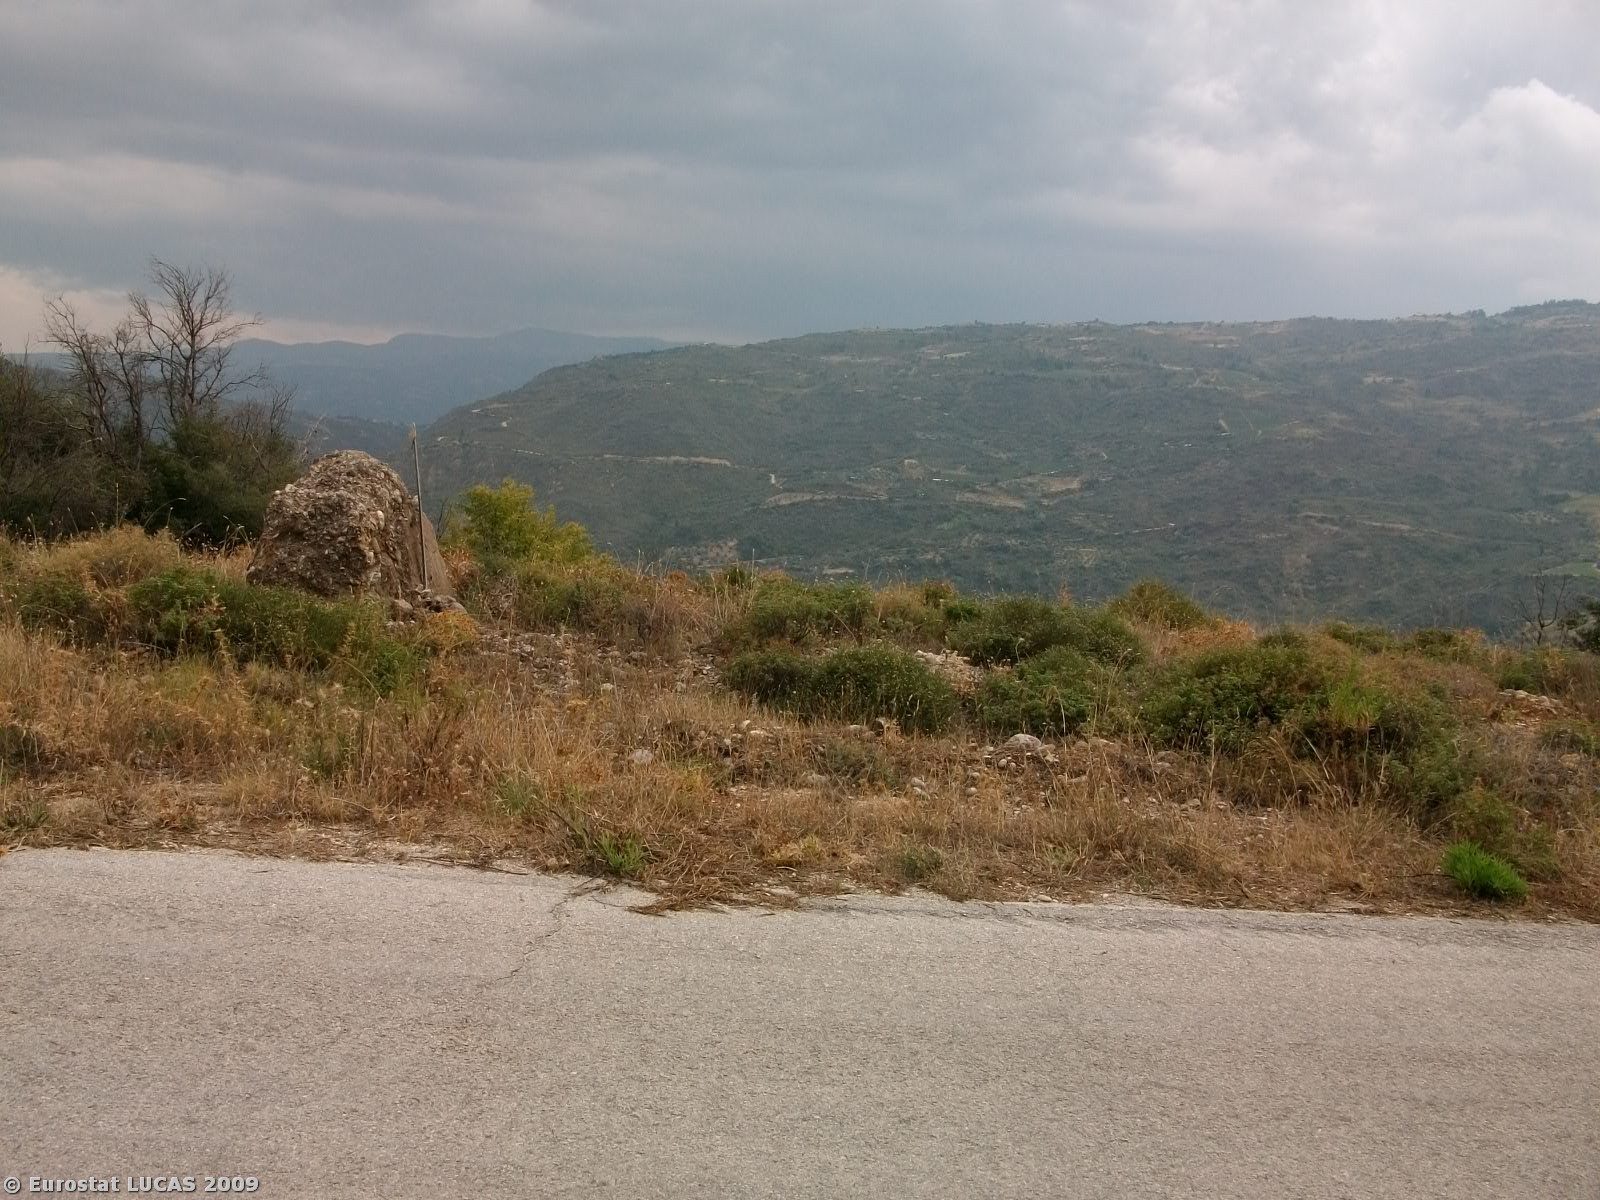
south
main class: Shrubland
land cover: Shrubland without tree cover
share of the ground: > 75 %
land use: Unused
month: September
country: GR
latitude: 38.0709
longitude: 22.5208
